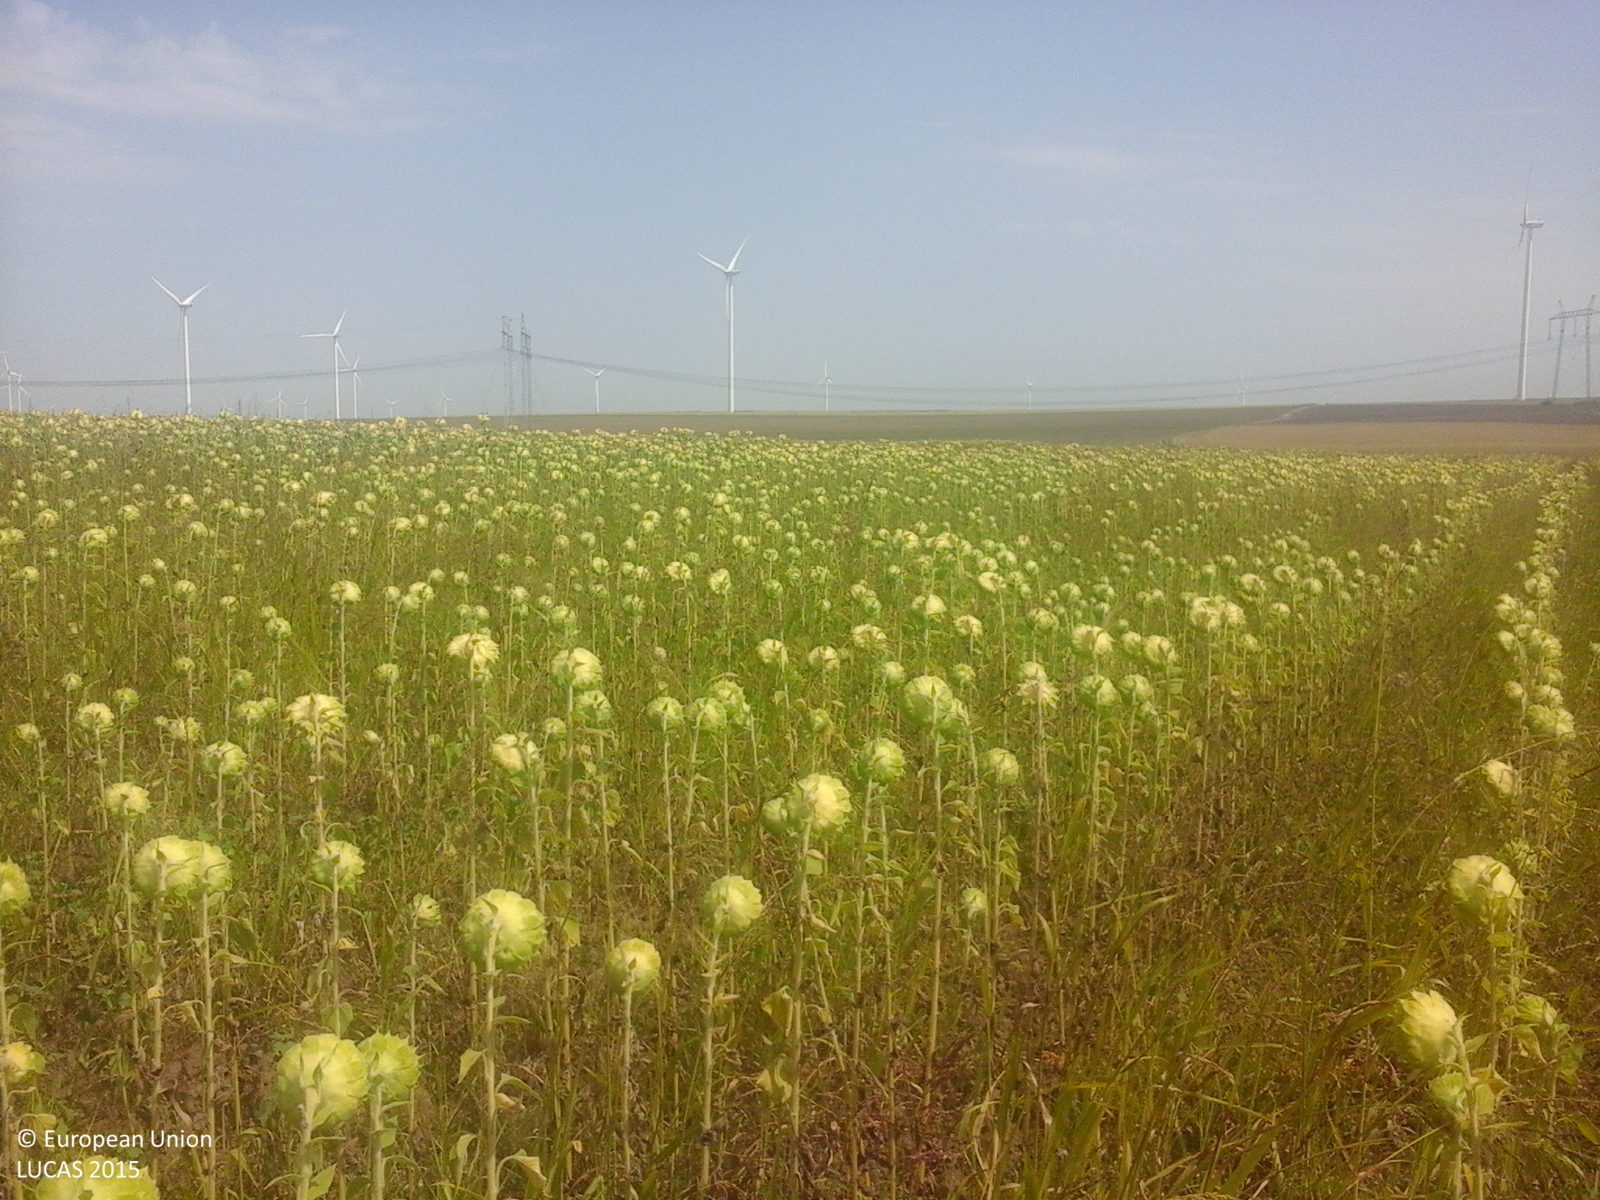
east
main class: Cropland
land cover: Sunflower
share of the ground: > 75 %
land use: Agriculture (excluding fallow land and kitchen gardens)
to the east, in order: Sunflower; Common wheat; Other bare soil
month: August
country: RO
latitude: 44.3066
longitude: 28.1229
